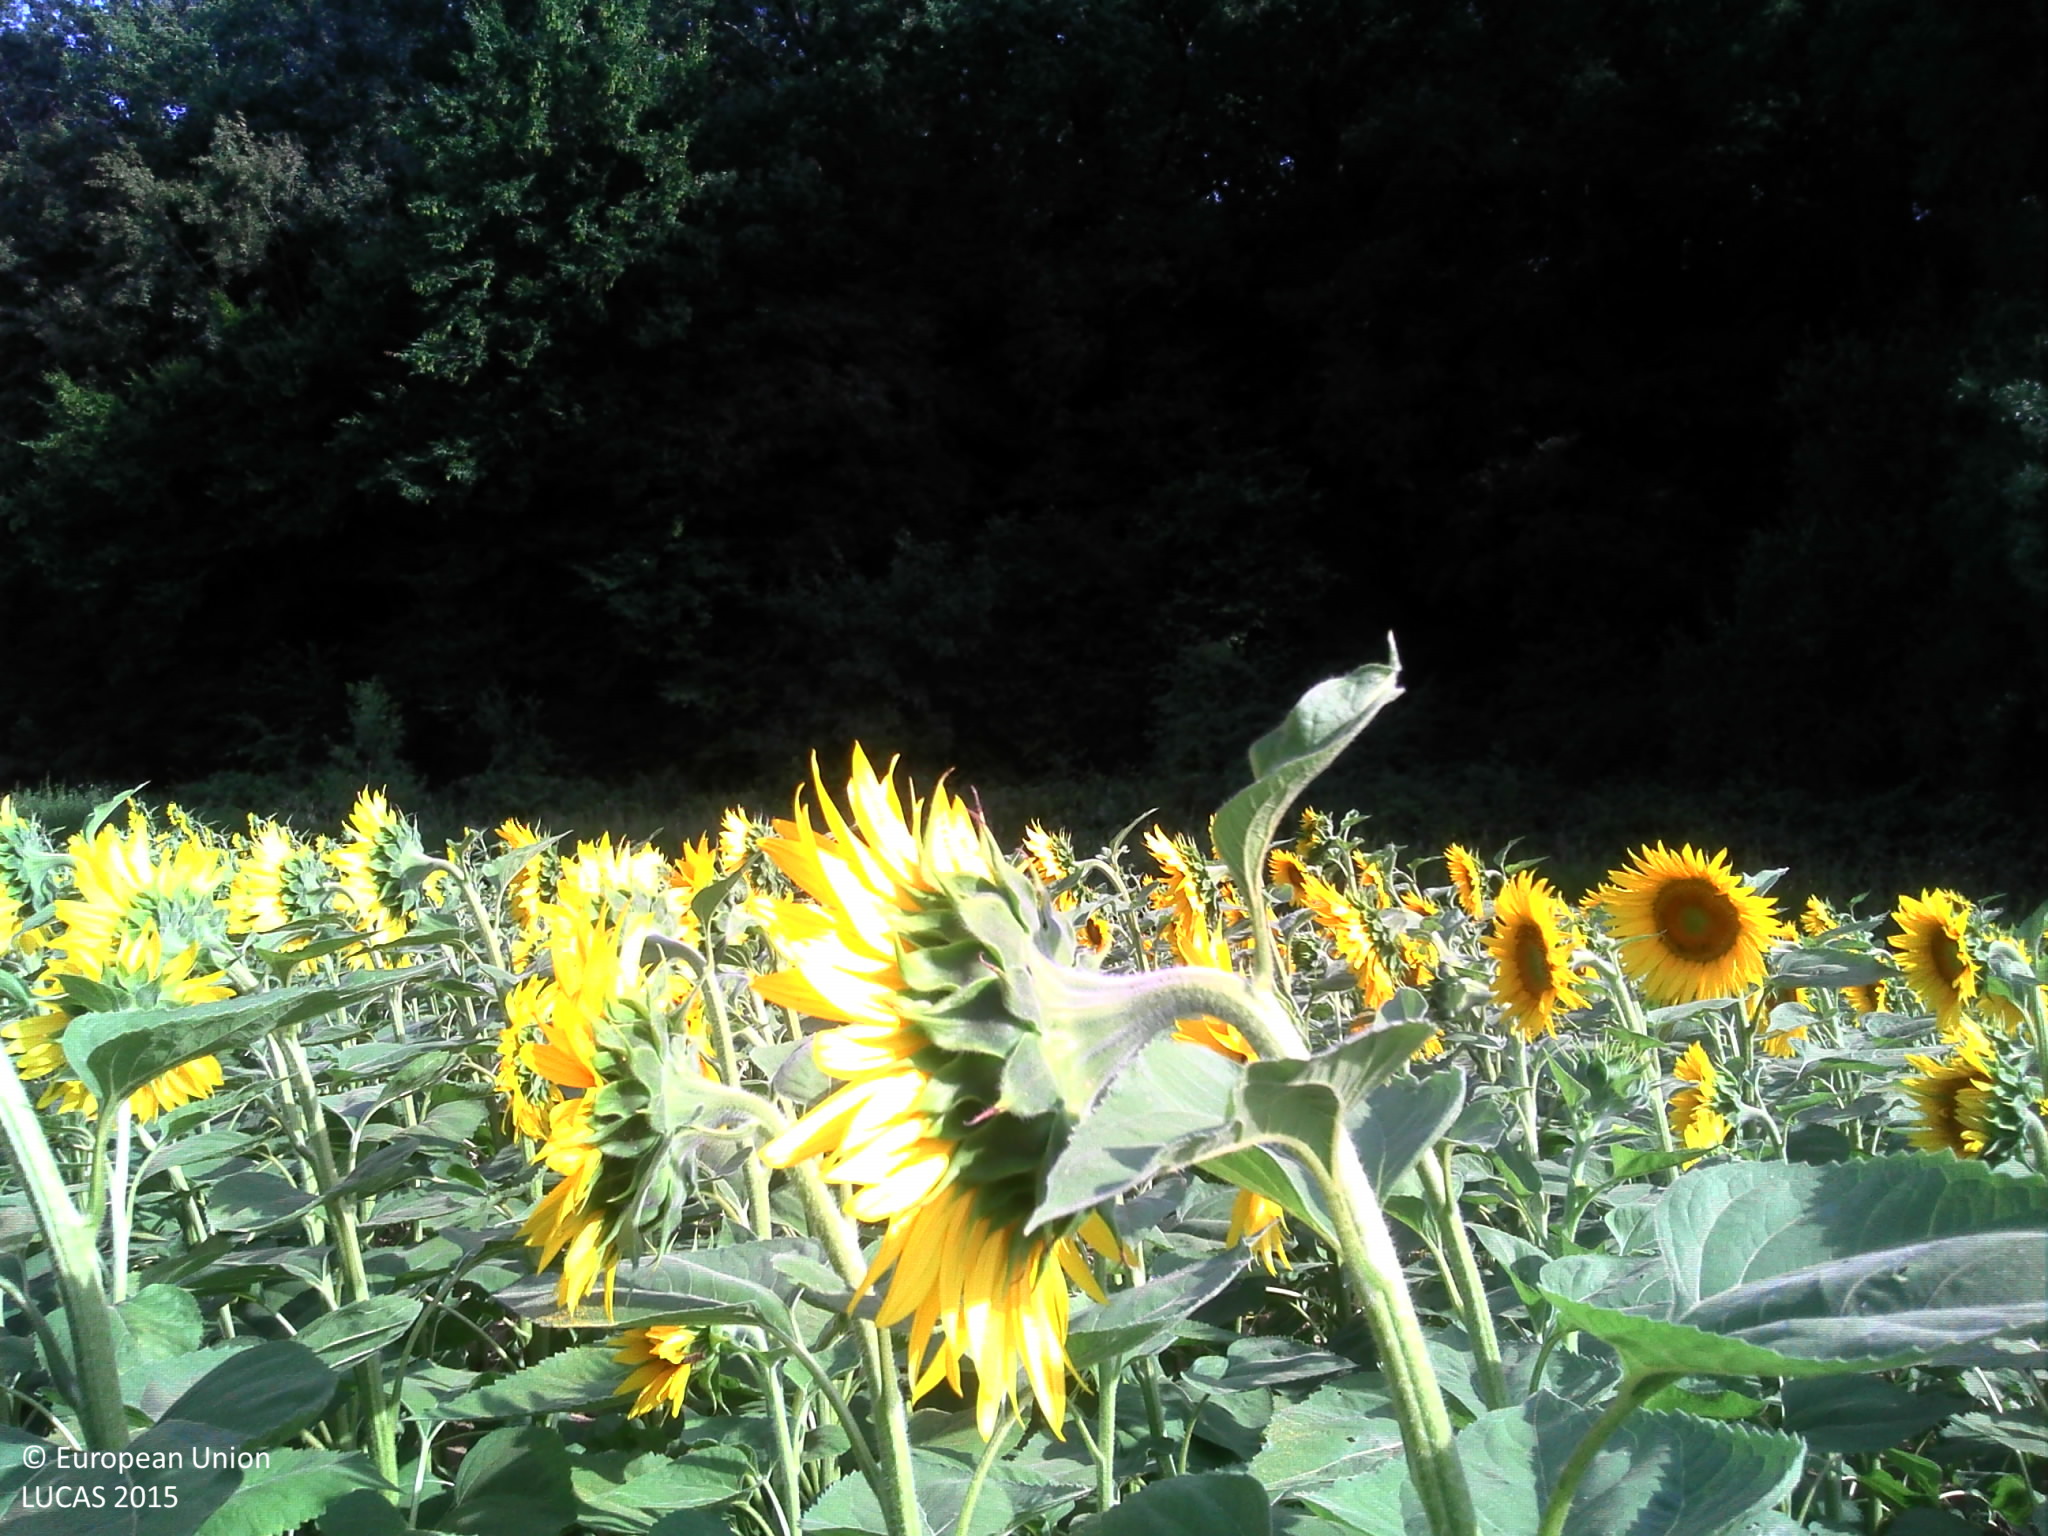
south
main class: Cropland
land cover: Sunflower
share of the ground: > 75 %
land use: Agriculture (excluding fallow land and kitchen gardens)
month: July
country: FR
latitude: 43.6457
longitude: 1.5852
